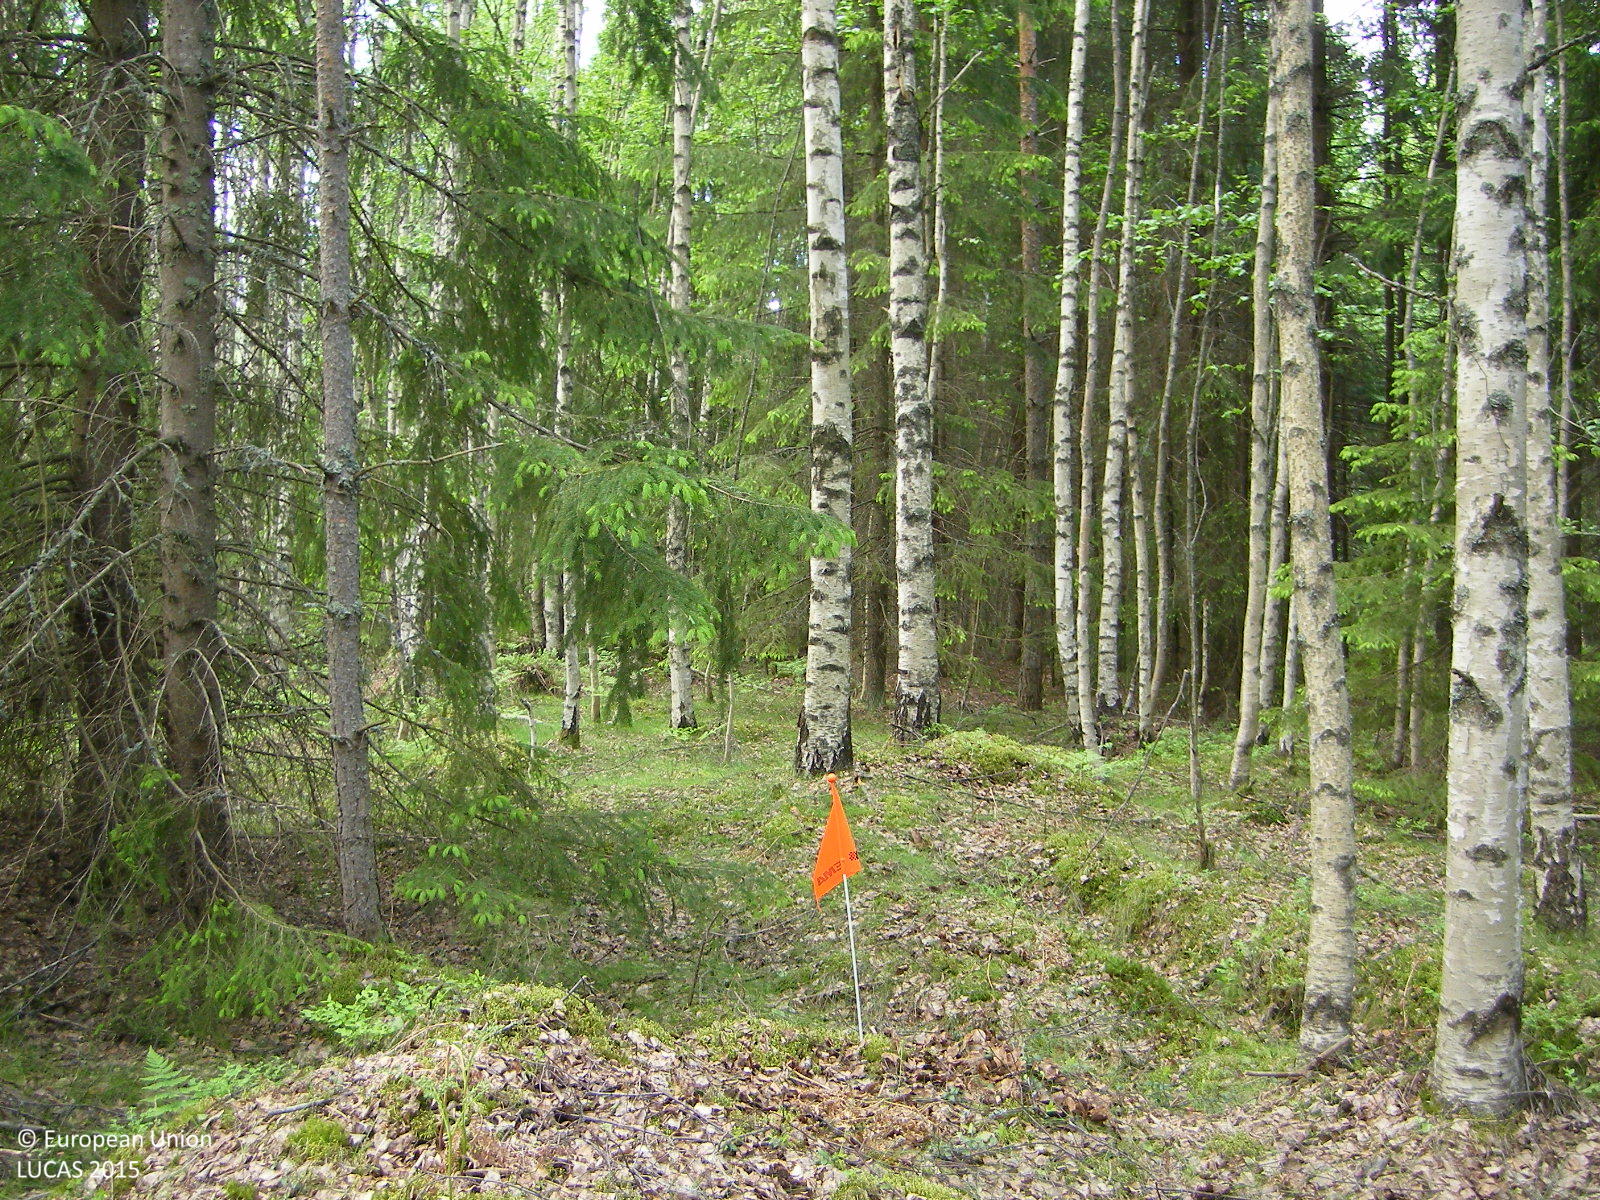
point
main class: Woodland
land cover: Spruce dominated mixed woodland
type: boreal forest
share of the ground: > 75 %
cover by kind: broadleaved forest trees 60 %, coniferous forest trees 30 %, herbaceous plants 5 %, lichens and mosses 5 %
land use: Forestry
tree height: > 5 m
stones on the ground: < 10 %
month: June
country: FI
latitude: 60.1907
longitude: 24.5550
